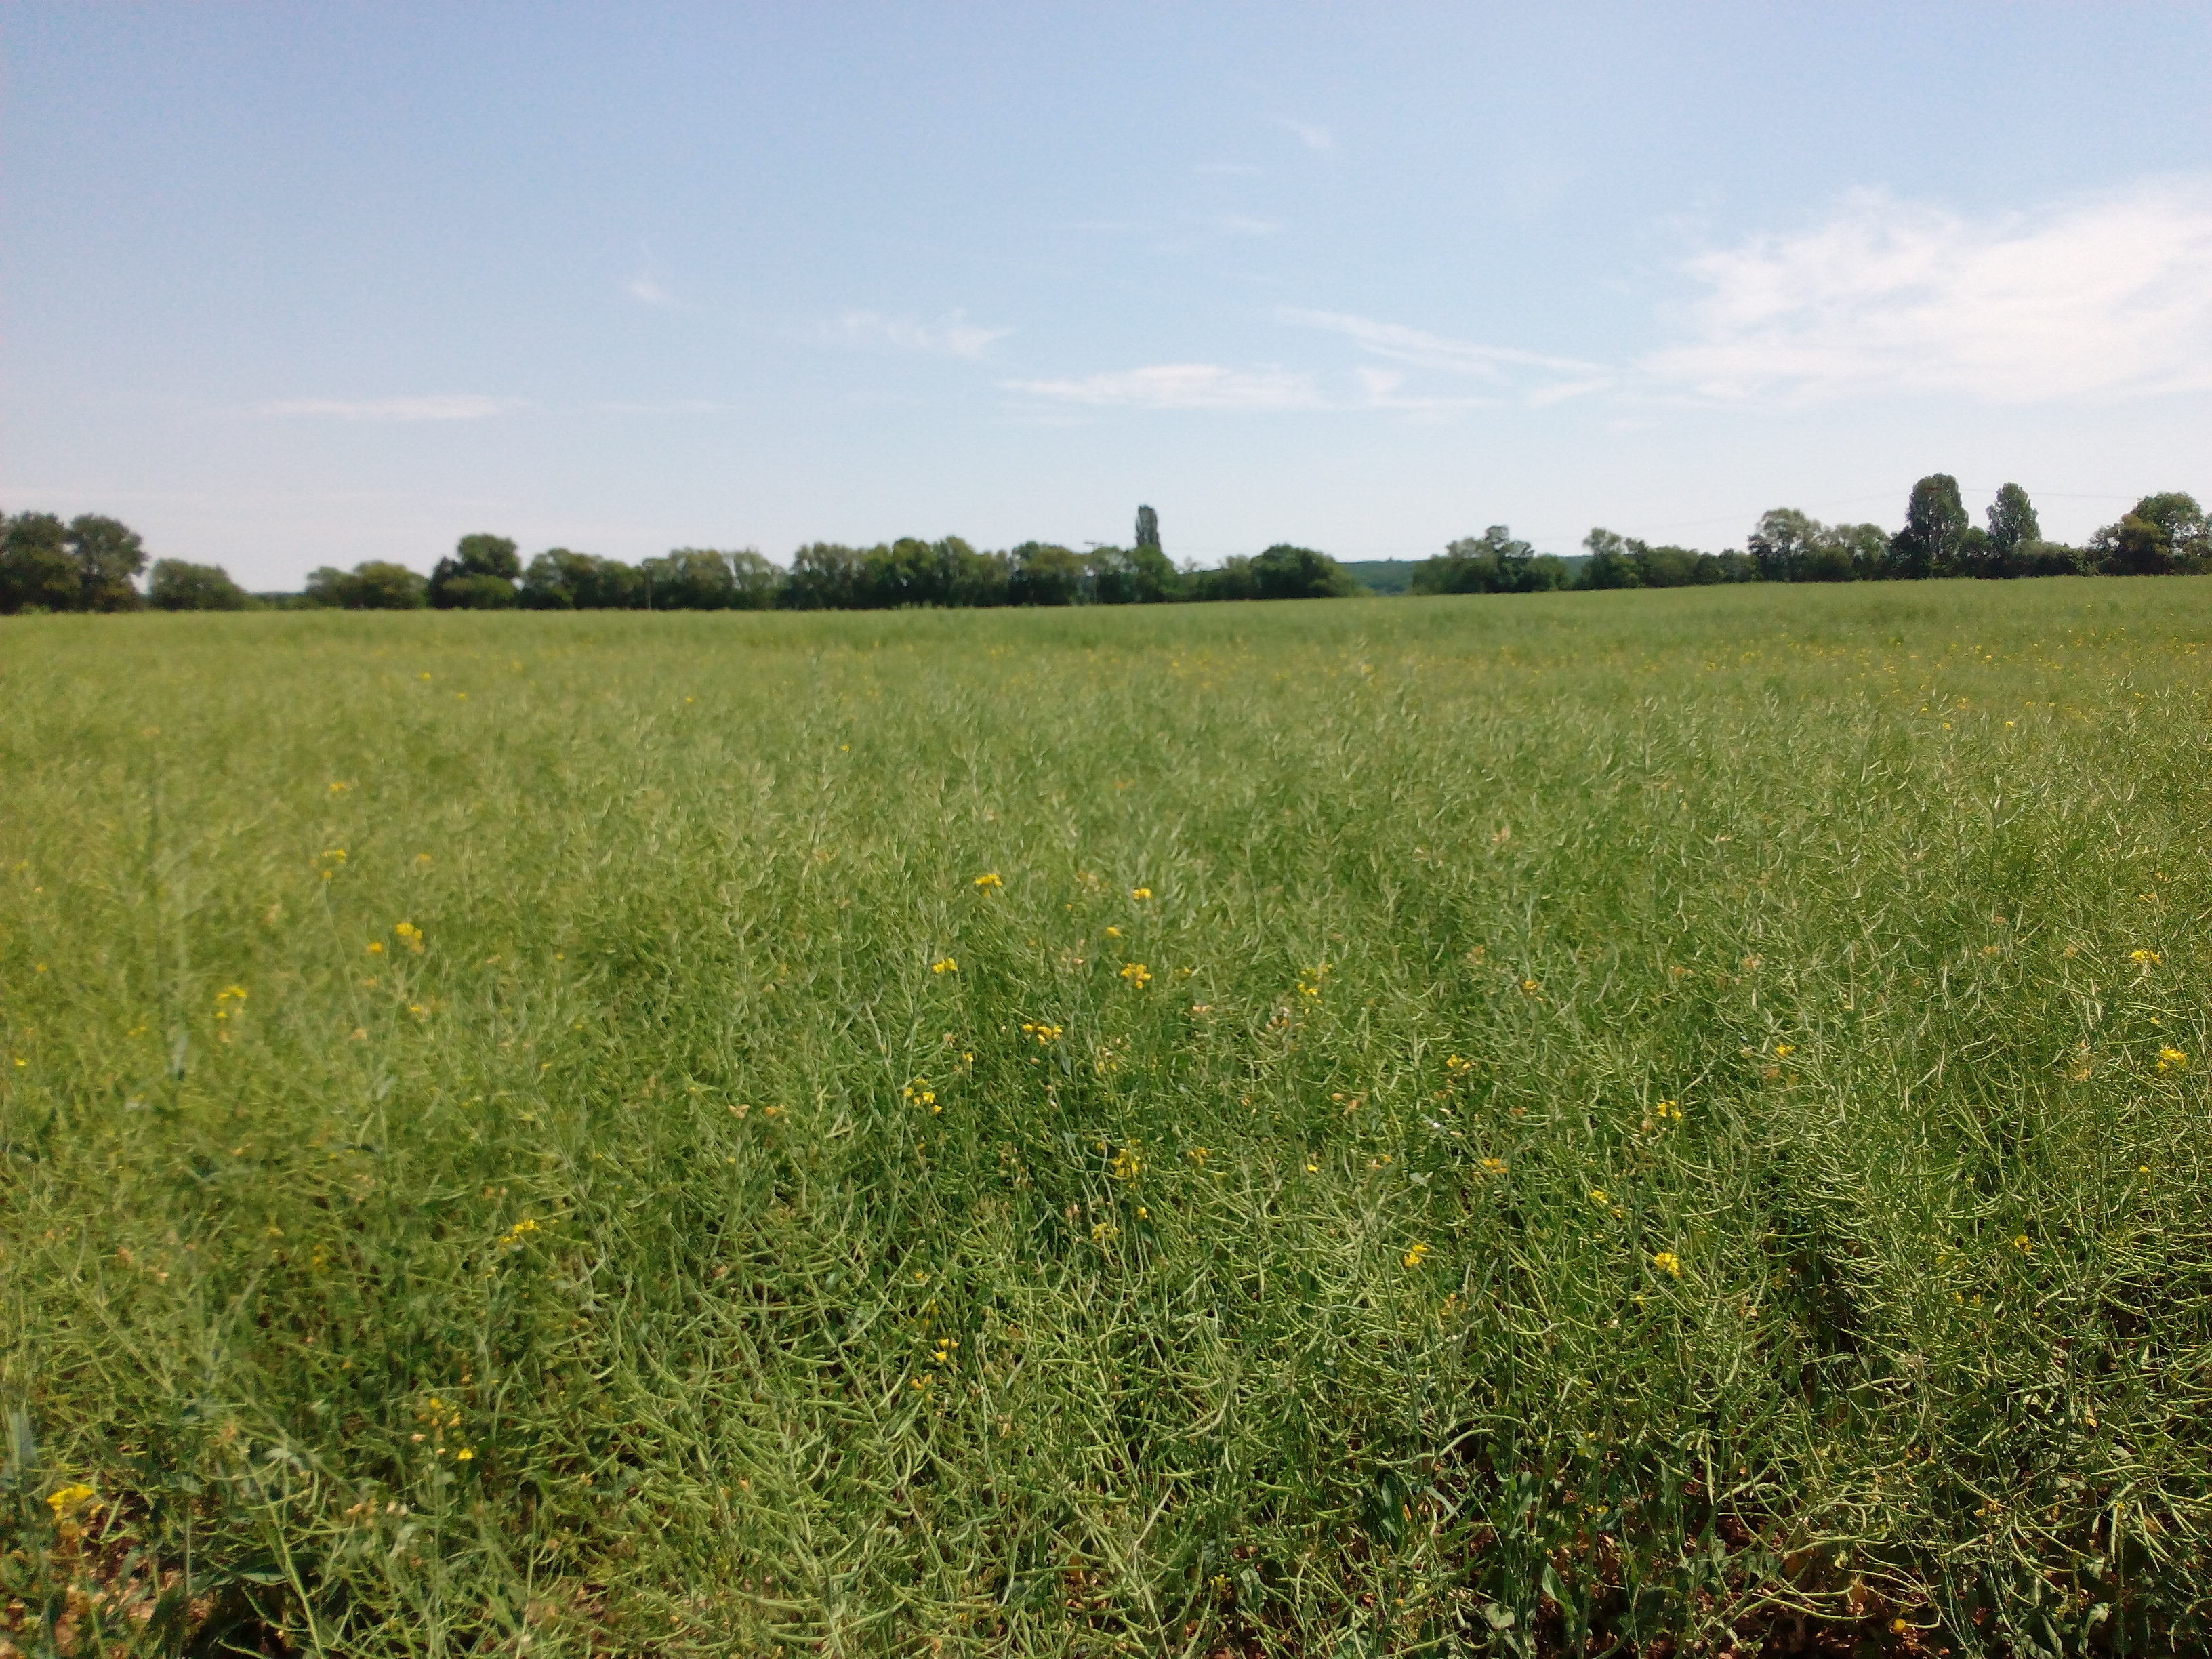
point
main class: Cropland
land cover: Rape and turnip rape
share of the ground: > 75 %
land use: Agriculture (excluding fallow land and kitchen gardens)
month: June
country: DE
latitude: 50.8657
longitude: 10.6392
